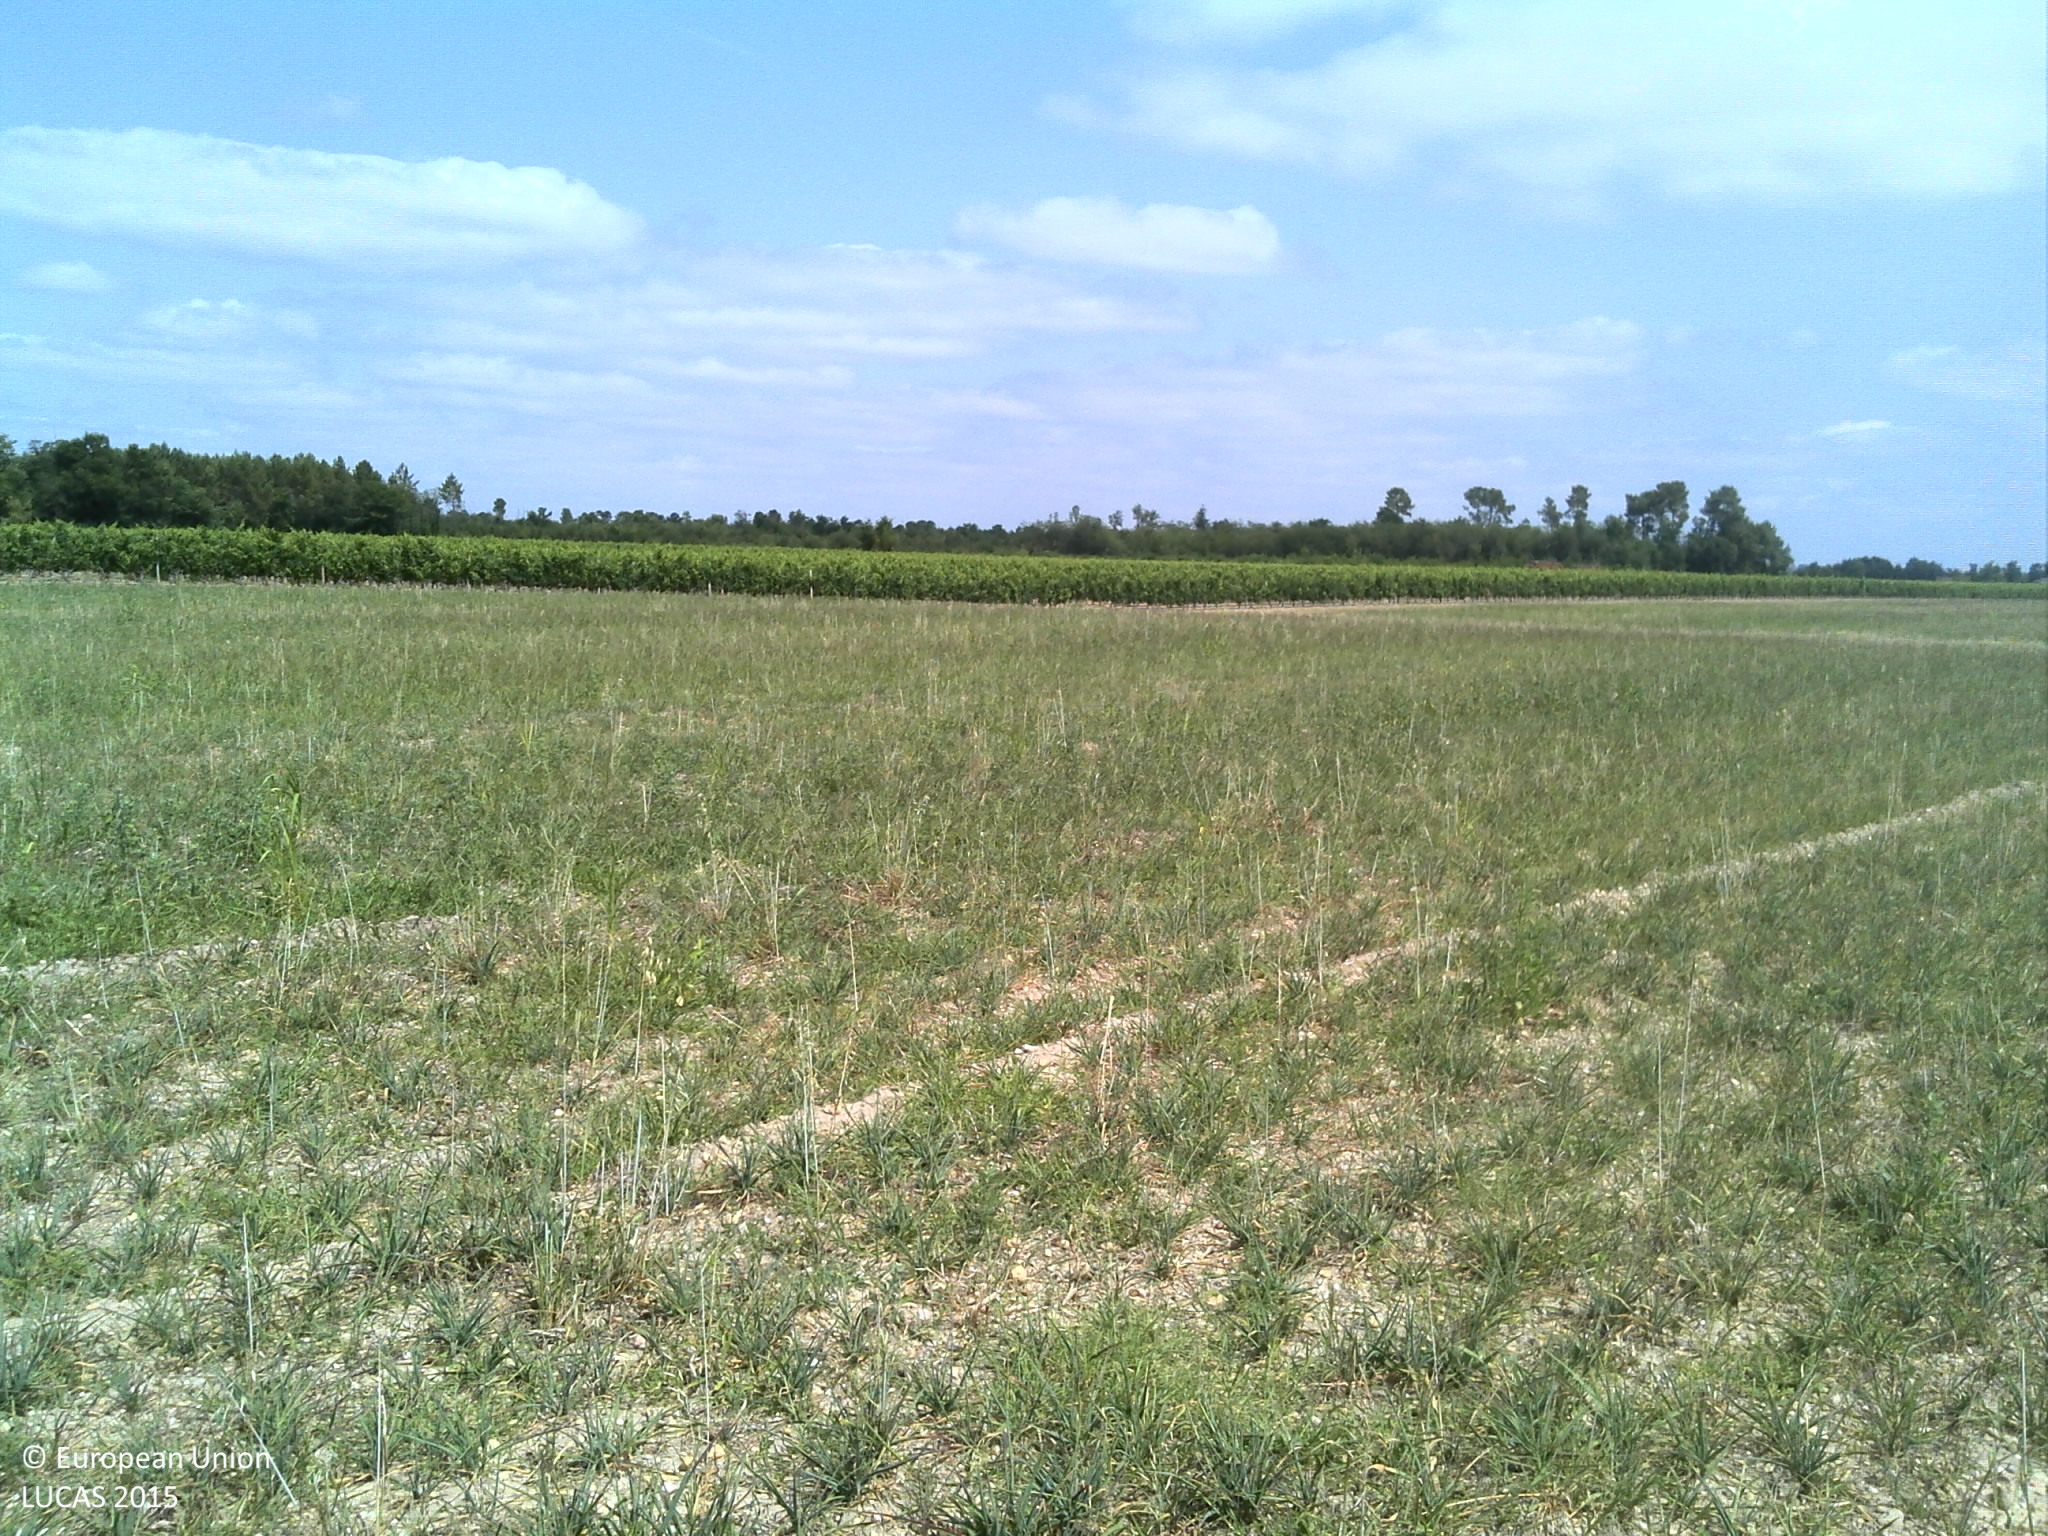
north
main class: Grassland
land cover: Spontaneously vegetated surfaces
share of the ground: > 75 %
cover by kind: herbaceous plants 95 %, shrubs 5 %
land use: Fallow land
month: July
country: FR
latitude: 44.6604
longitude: -0.4206
